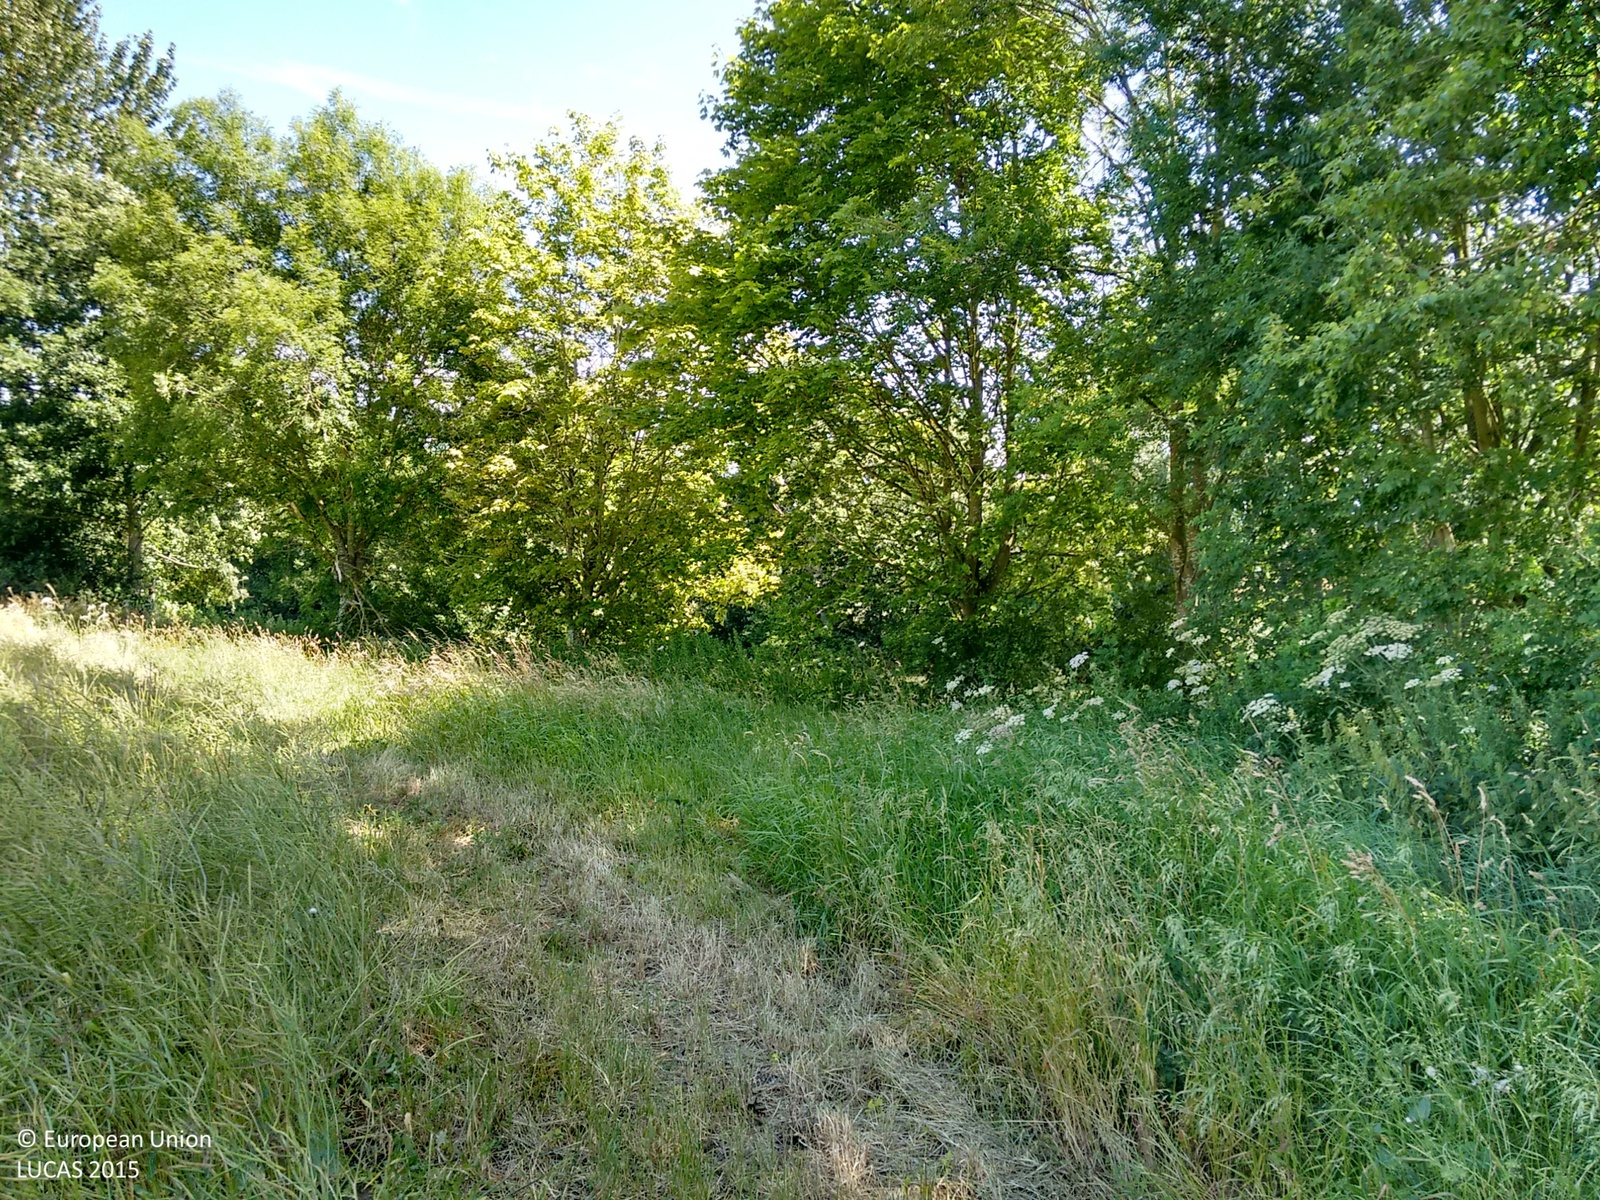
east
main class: Cropland
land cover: Rape and turnip rape
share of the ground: > 75 %
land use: Agriculture (excluding fallow land and kitchen gardens)
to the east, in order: Rape and turnip rape; Grass margins; Tracks; Grass margins; Inland fresh running water; Managed hedges; Common wheat
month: July
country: GB
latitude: 51.6796
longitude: -1.2270
